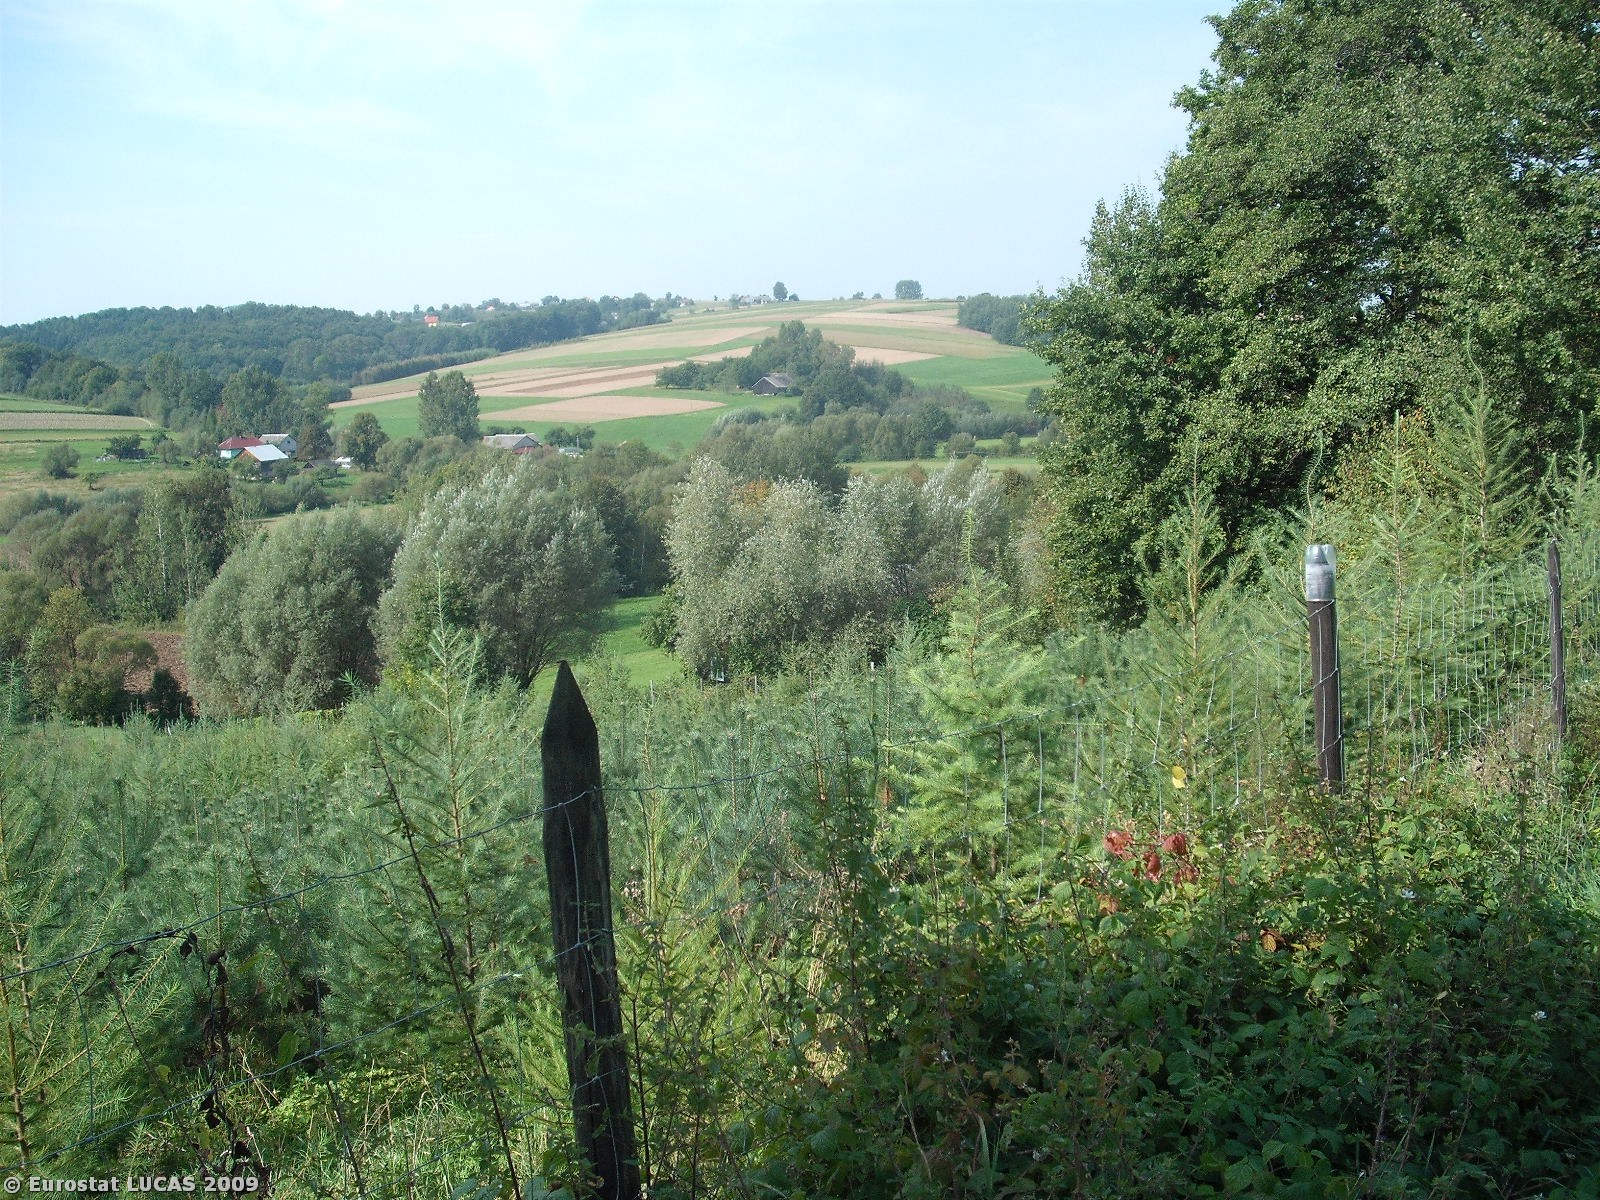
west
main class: Woodland
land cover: Coniferous woodland
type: hemiboreal forest and nemoral coniferous forest and mixed broadleaved-coniferous forest
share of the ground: 50 - 75 %
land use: Agriculture (excluding fallow land and kitchen gardens)
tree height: > 5 m
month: September
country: PL
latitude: 49.7213
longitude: 21.0153
